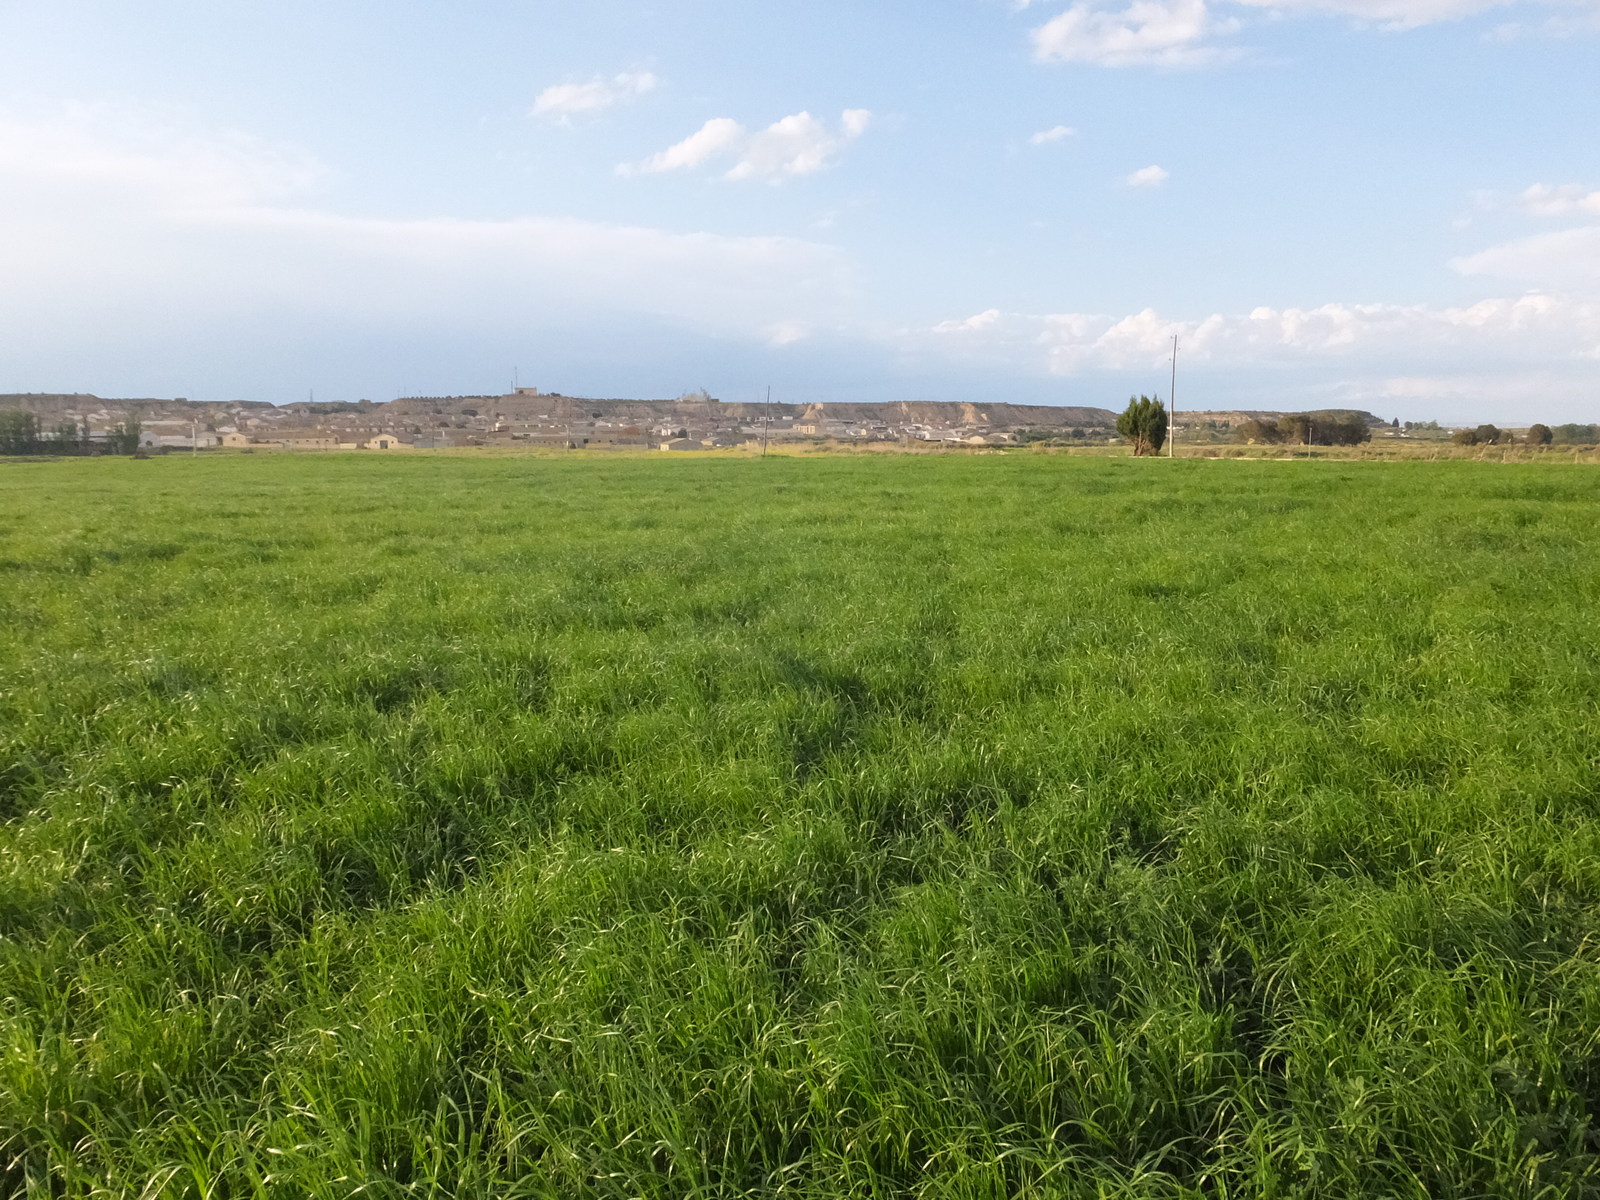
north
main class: Cropland
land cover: Other leguminous and mixtures for fodder
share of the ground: > 75 %
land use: Agriculture (excluding fallow land and kitchen gardens)
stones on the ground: < 10 %
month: April
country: ES
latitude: 41.7609
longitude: -0.3267
